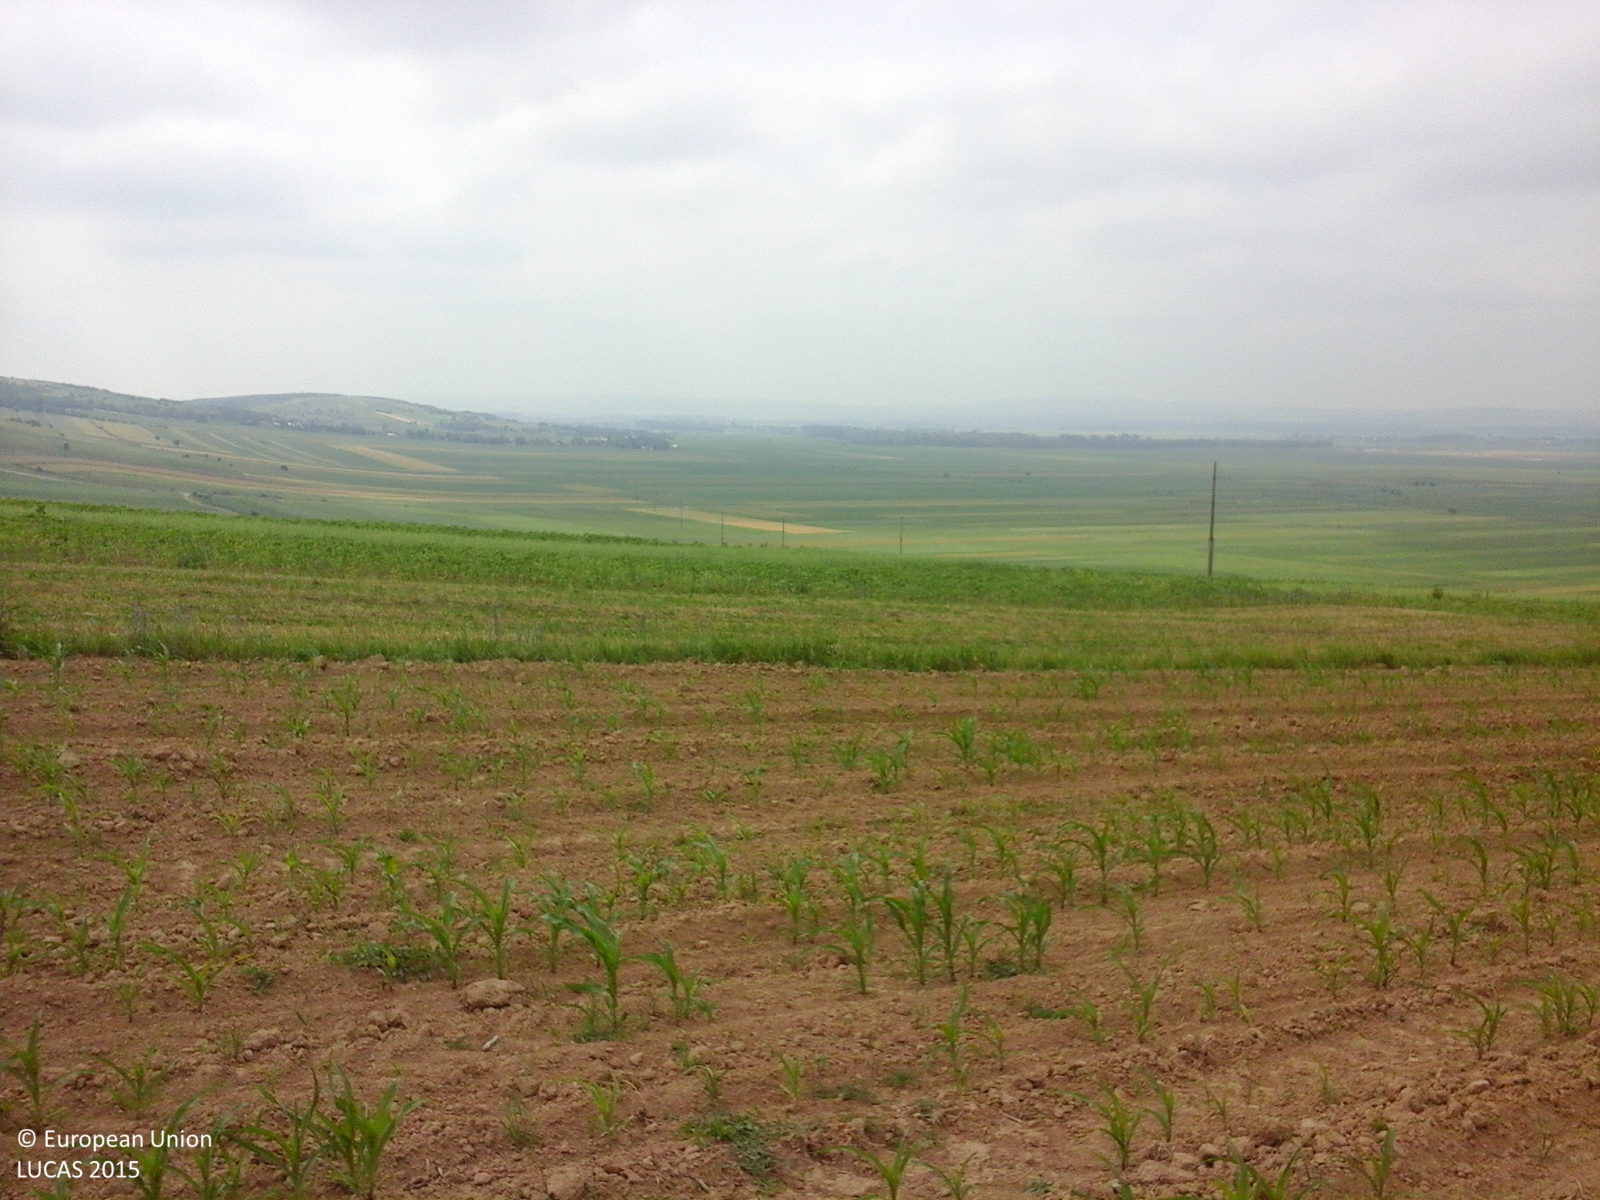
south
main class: Cropland
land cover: Maize
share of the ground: 10 - 25 %
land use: Agriculture (excluding fallow land and kitchen gardens)
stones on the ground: < 10 %
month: June
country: RO
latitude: 47.6181
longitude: 26.5767
